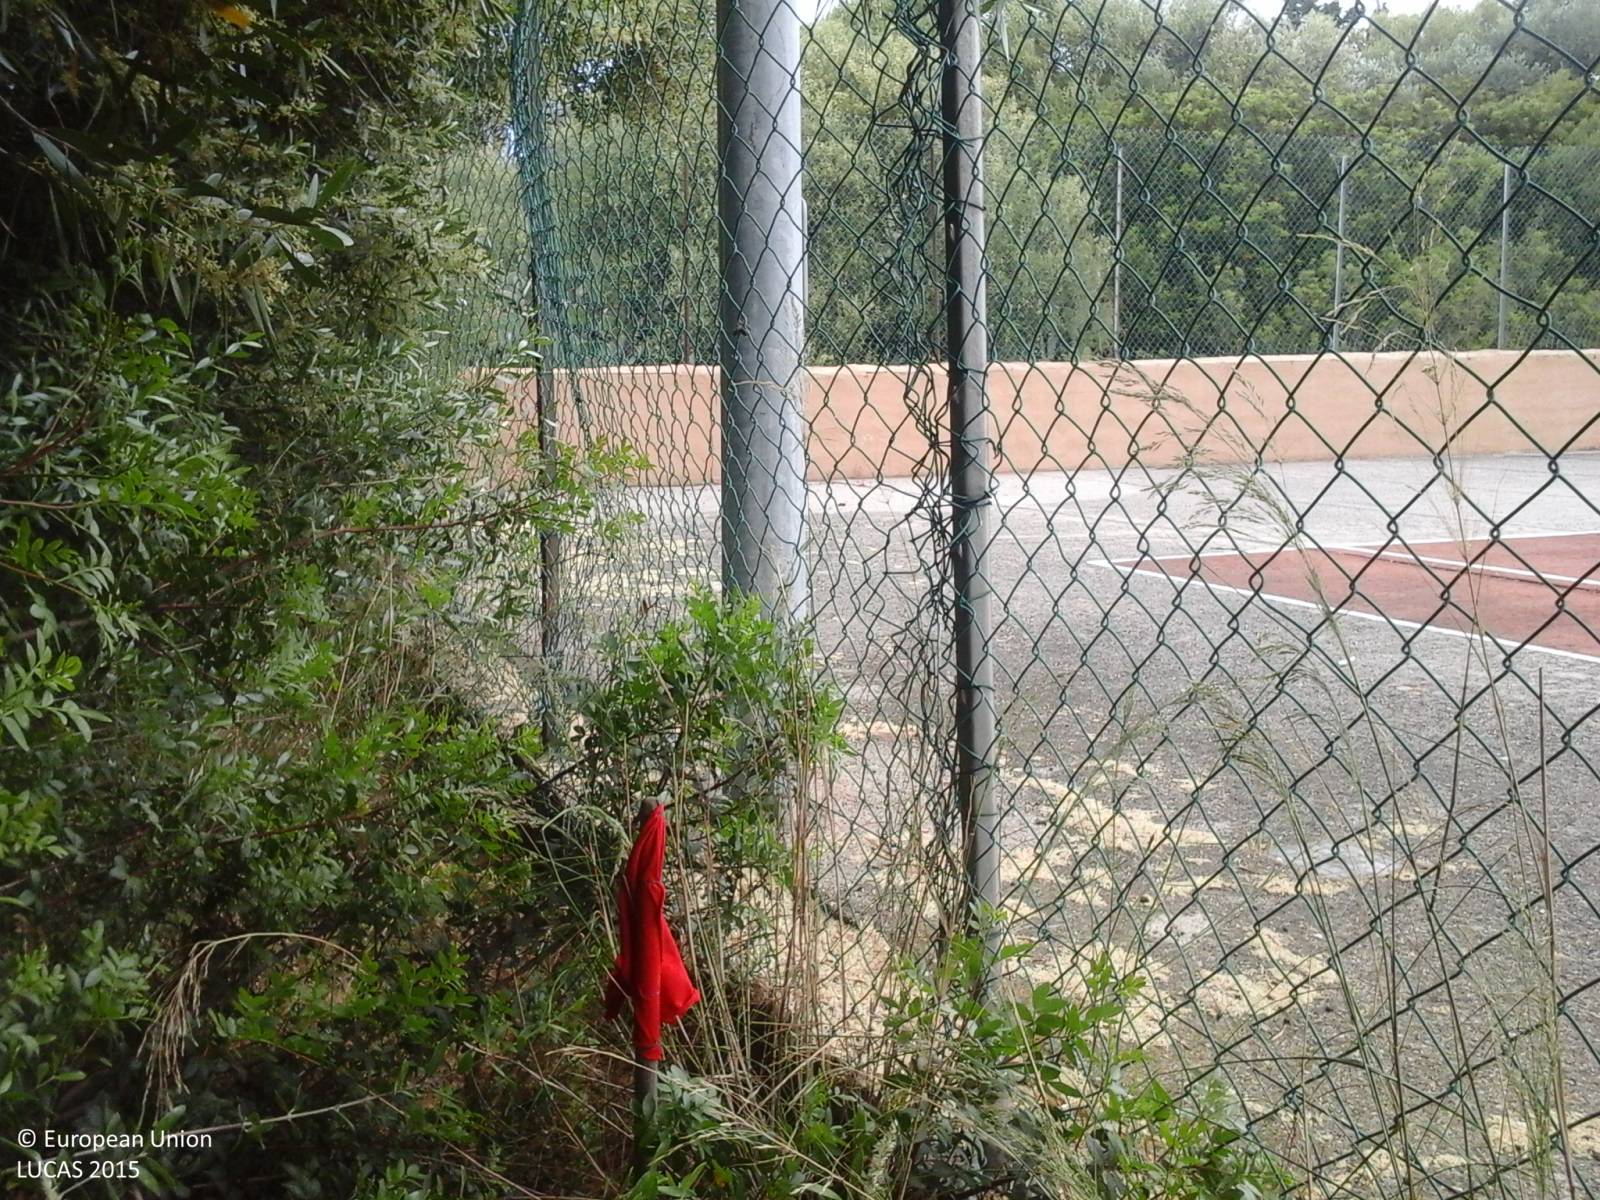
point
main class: Woodland
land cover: Broadleaved woodland
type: broadleaved evergreen forest
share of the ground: > 75 %
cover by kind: broadleaved forest trees 45 %, shrubs 45 %
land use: Amenities, museums, leisure
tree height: > 5 m
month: May
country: IT
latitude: 40.9667
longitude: 8.8764
